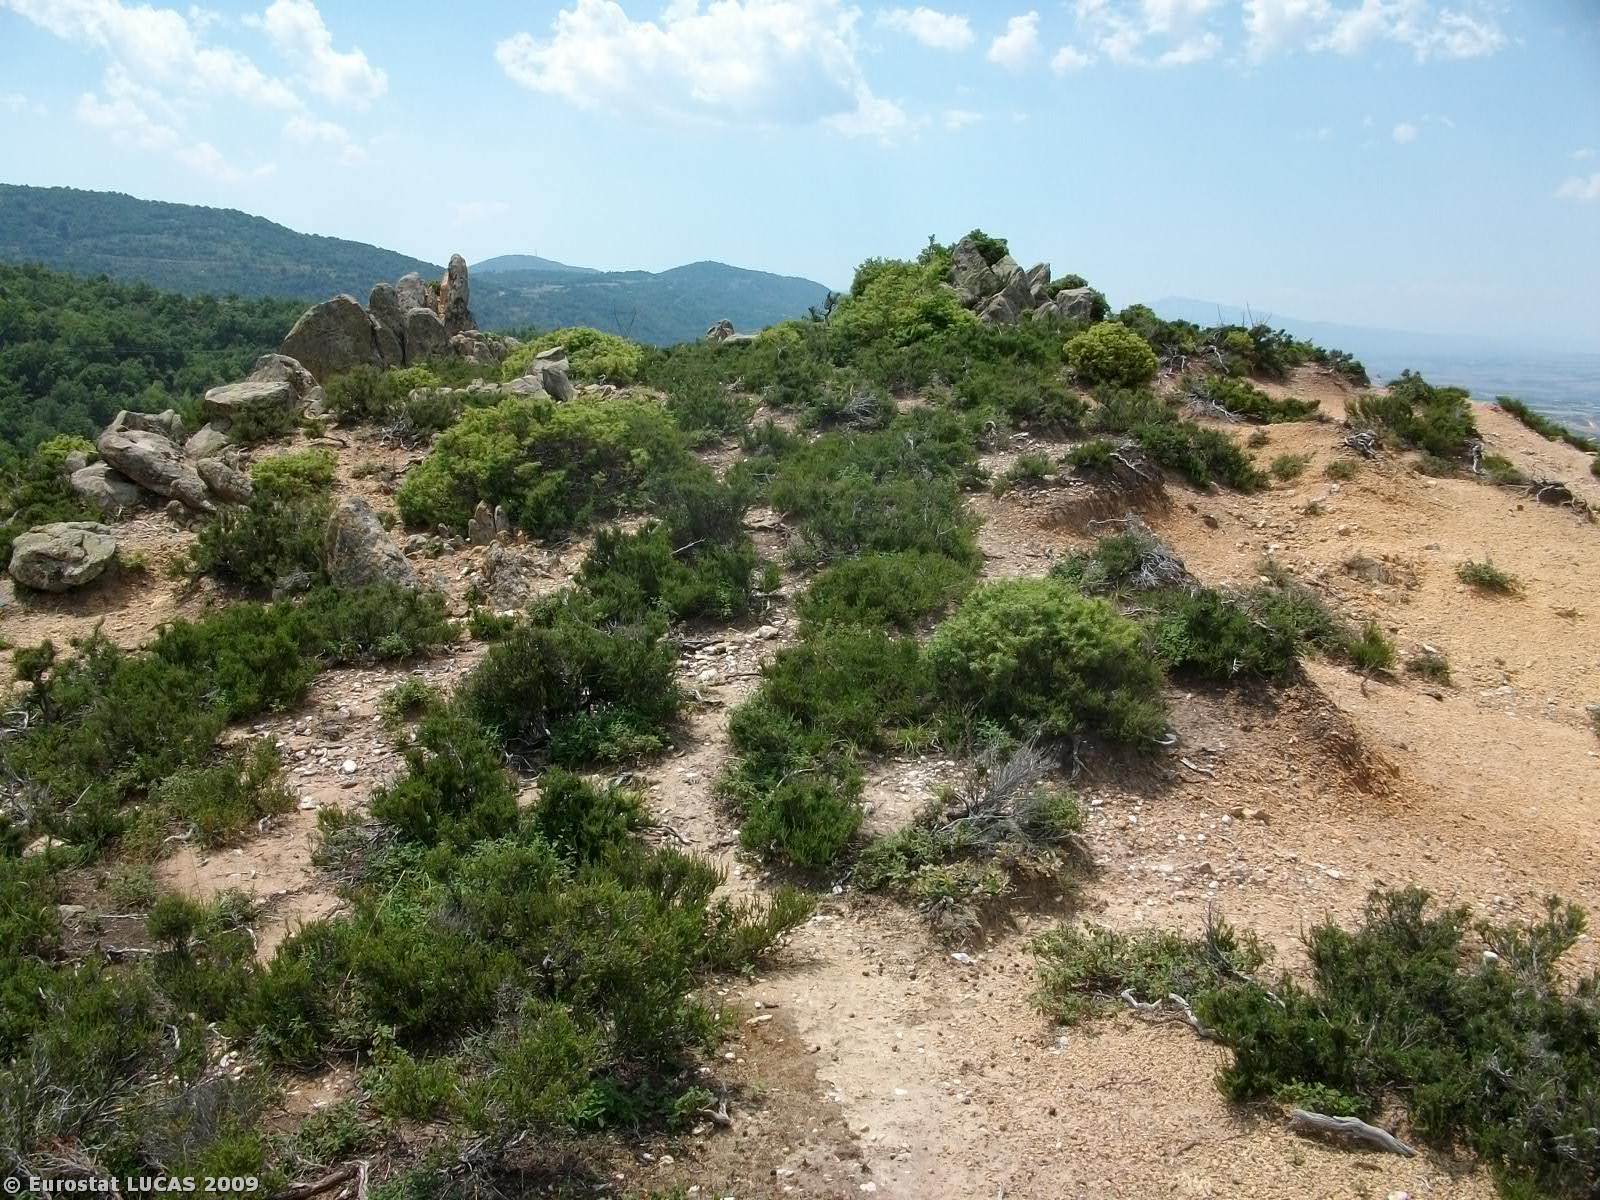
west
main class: Woodland
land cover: Mixed woodland
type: coniferous forest of the mediterranean region
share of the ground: > 75 %
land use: Nature reserves
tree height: > 5 m
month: July
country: GR
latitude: 40.4805
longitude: 23.5192
